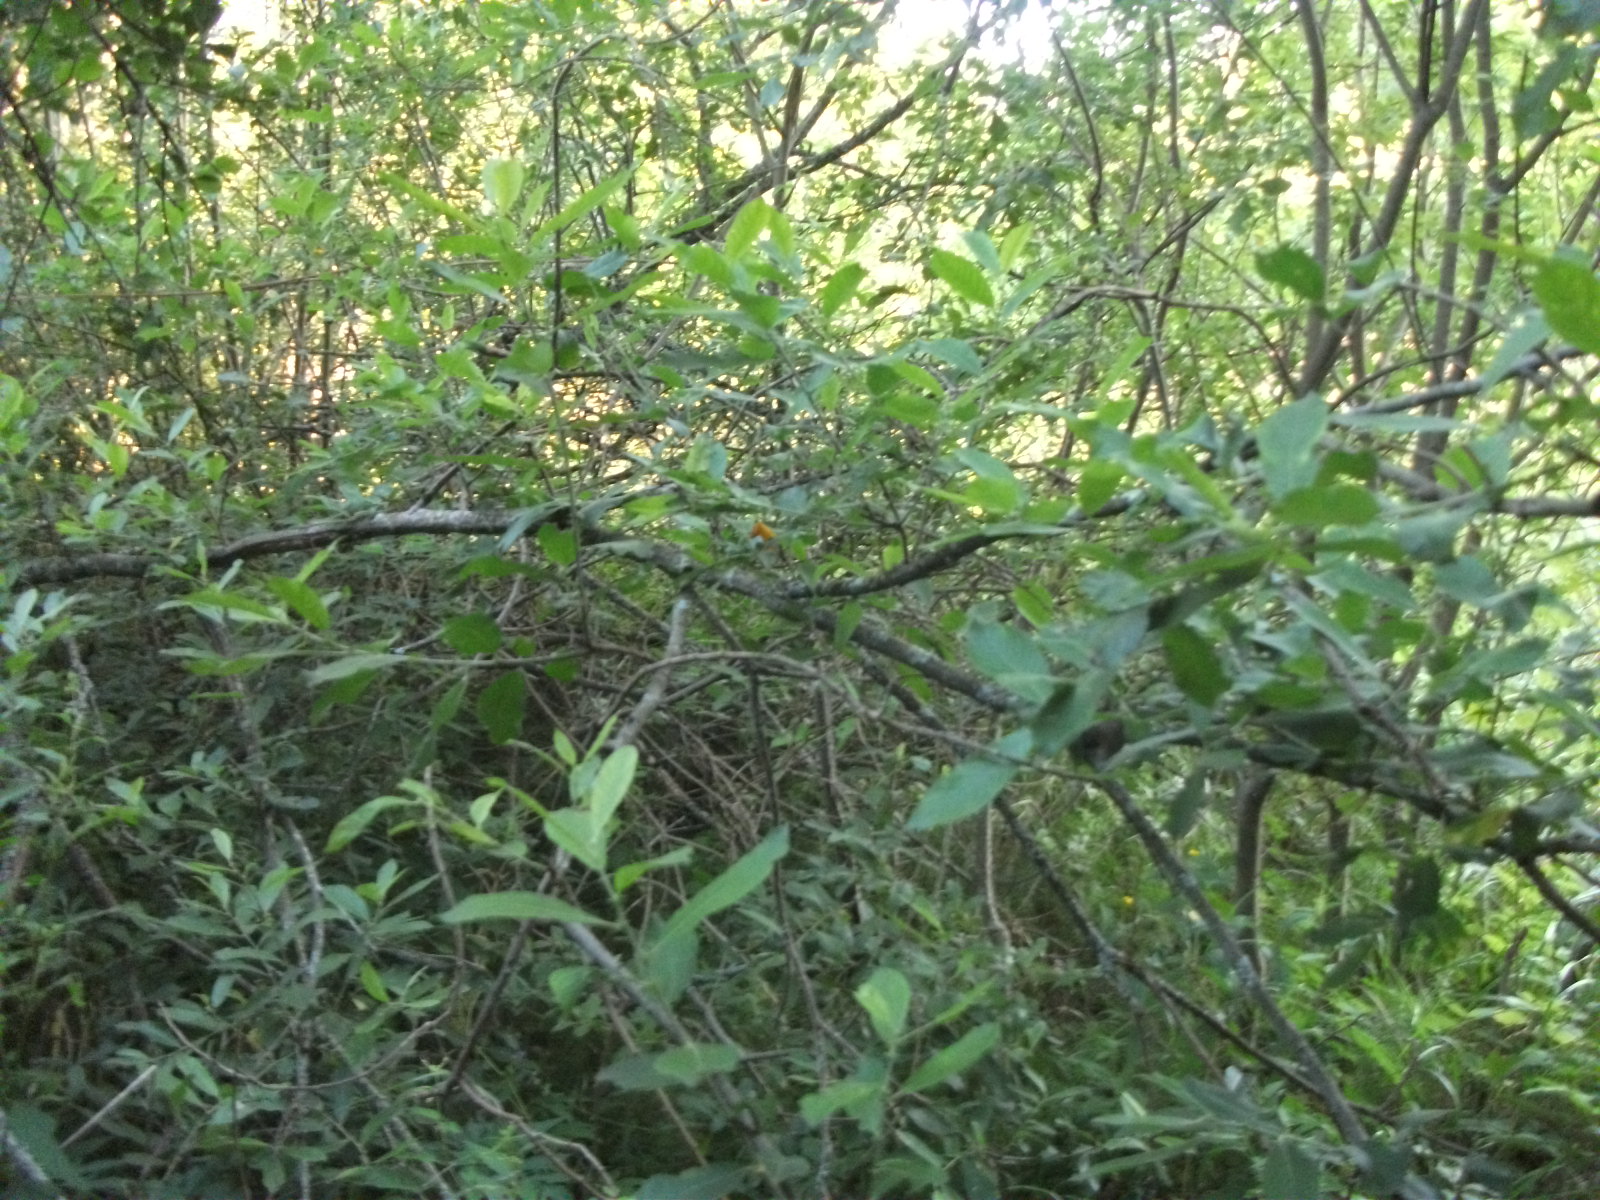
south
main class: Woodland
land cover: Broadleaved woodland
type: non-riverine alder, birch or aspen forest
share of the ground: 50 - 75 %
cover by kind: broadleaved forest trees 60 %, shrubs 30 %, herbaceous plants 10 %
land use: Abandoned areas
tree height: > 5 m
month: August
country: LV
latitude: 57.0829
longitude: 26.4617
